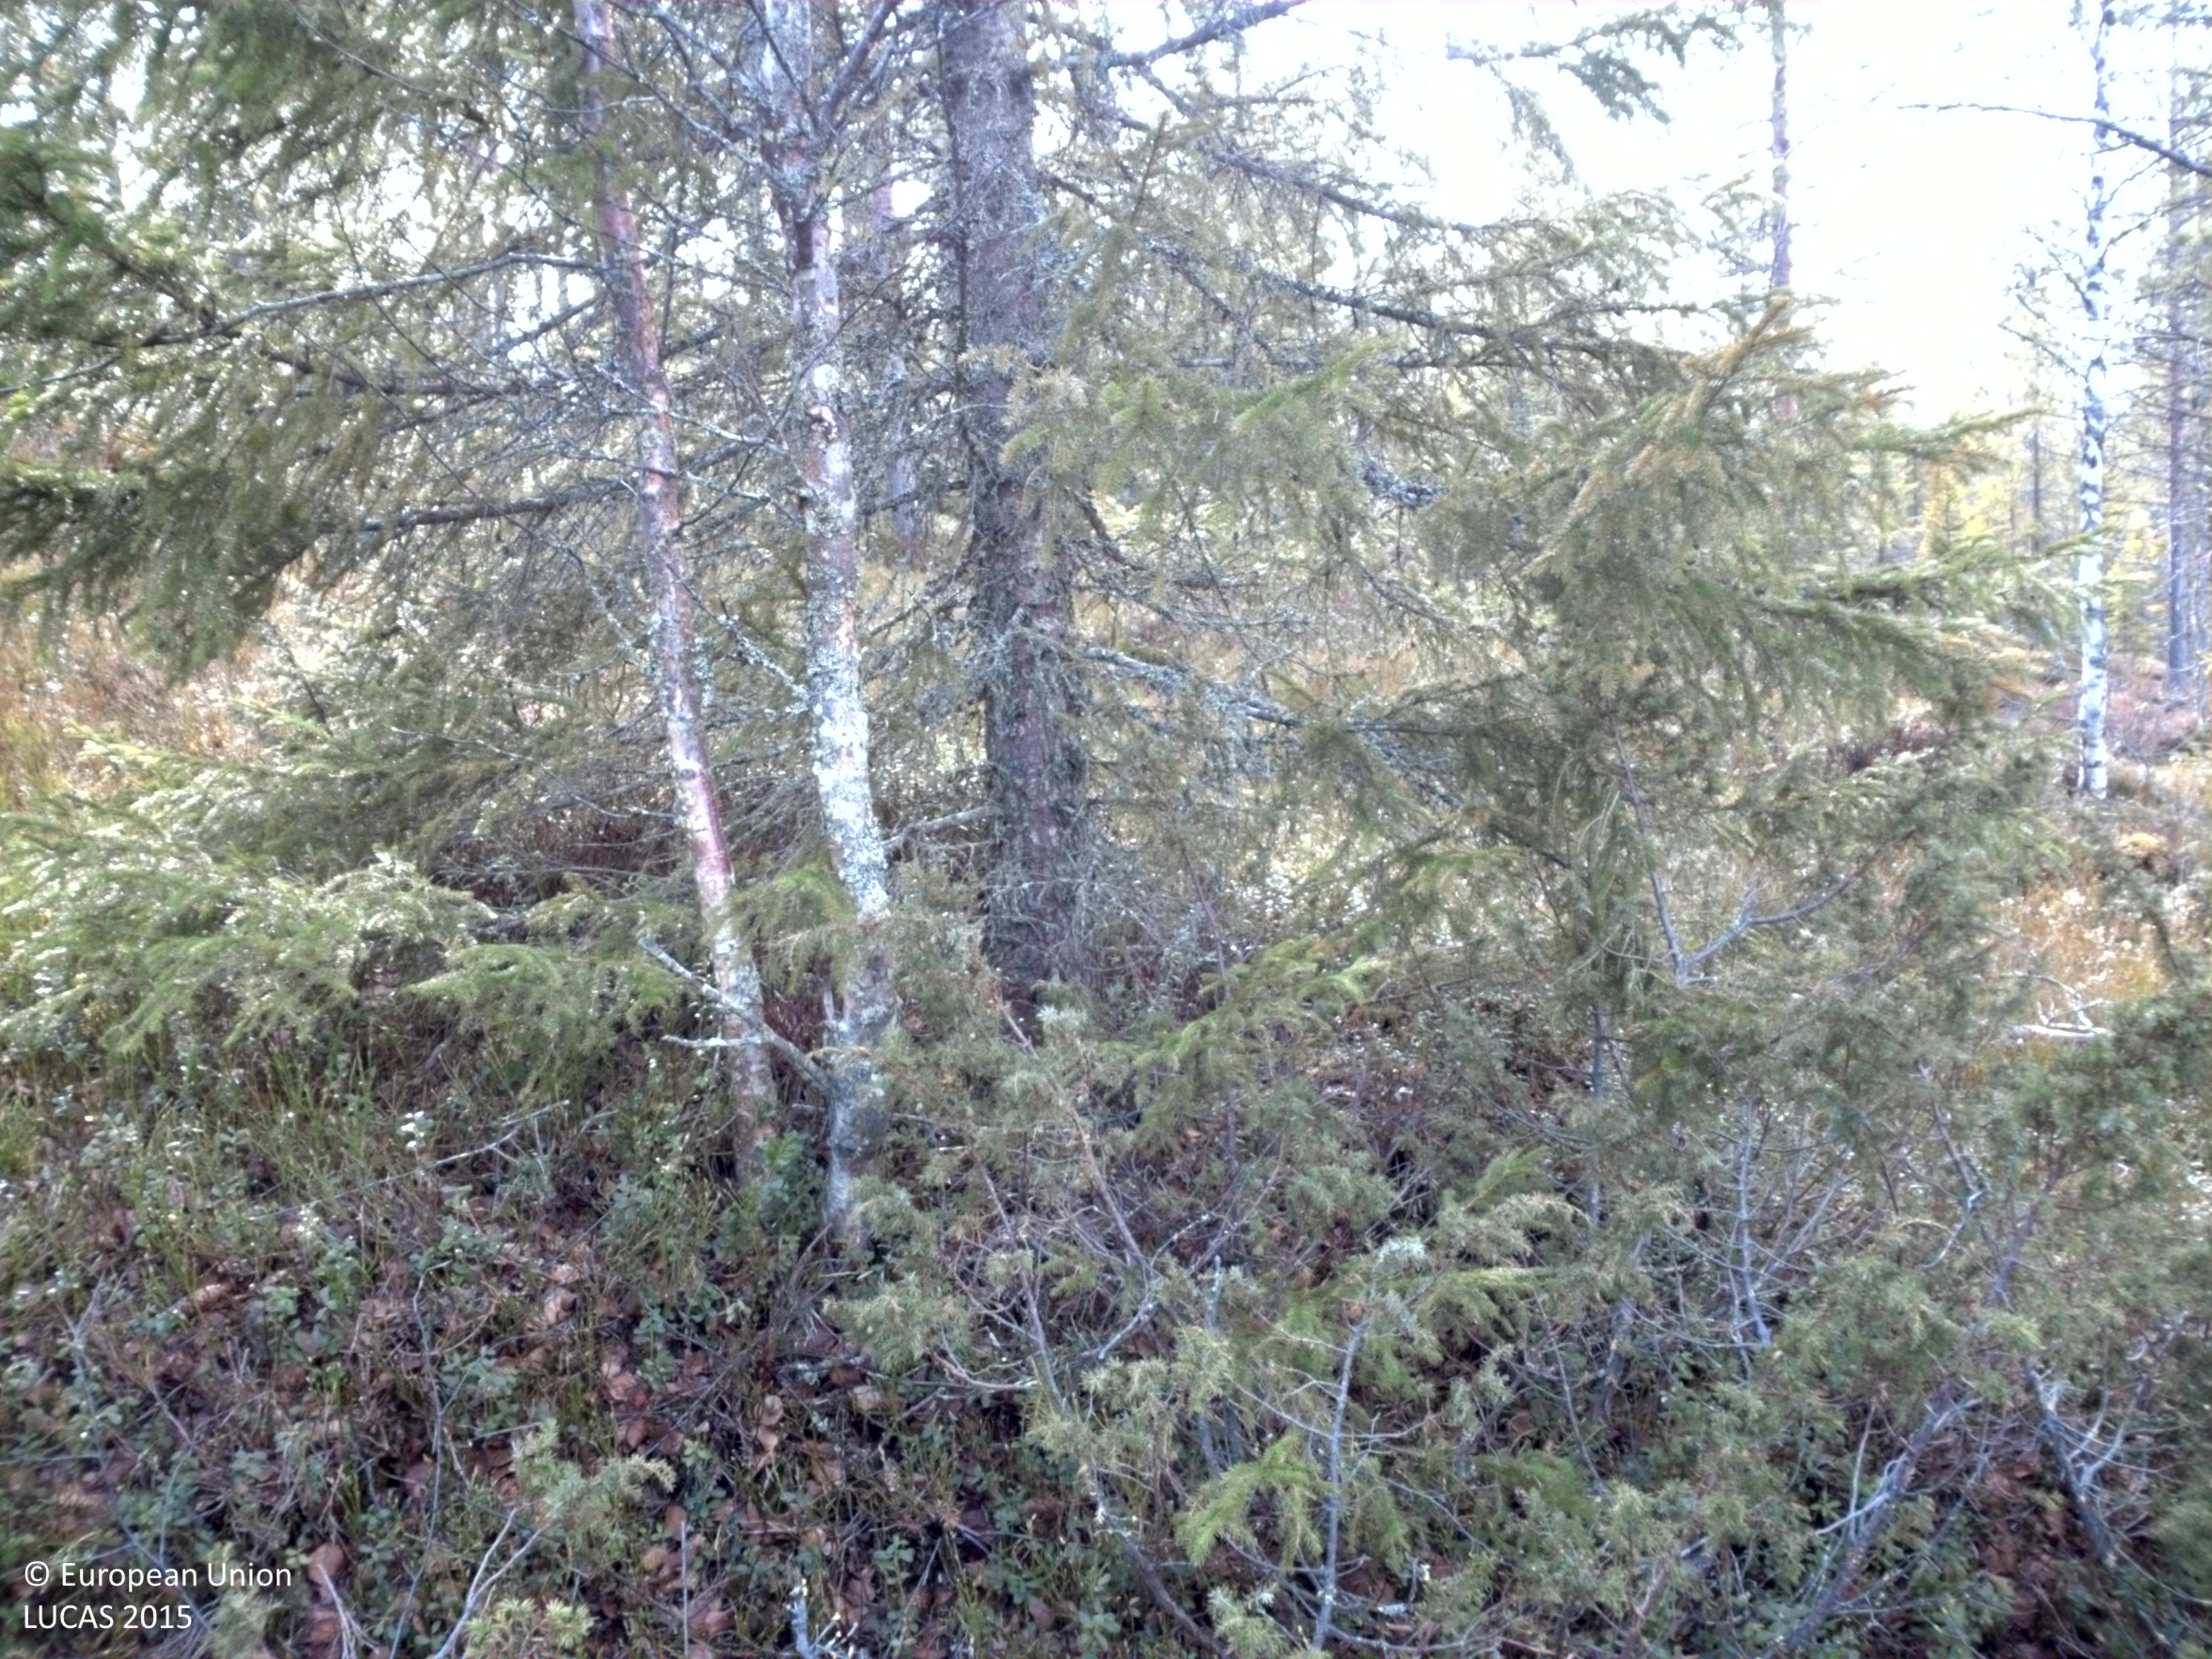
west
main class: Woodland
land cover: Spruce dominated coniferous woodland
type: boreal forest
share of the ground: 10 - 25 %
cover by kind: herbaceous plants 45 %, coniferous forest trees 25 %, shrubs 15 %, lichens and mosses 10 %, broadleaved forest trees 5 %
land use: Forestry
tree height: > 5 m
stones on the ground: 10 - 25 %
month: May
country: SE
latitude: 64.1952
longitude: 18.0203
